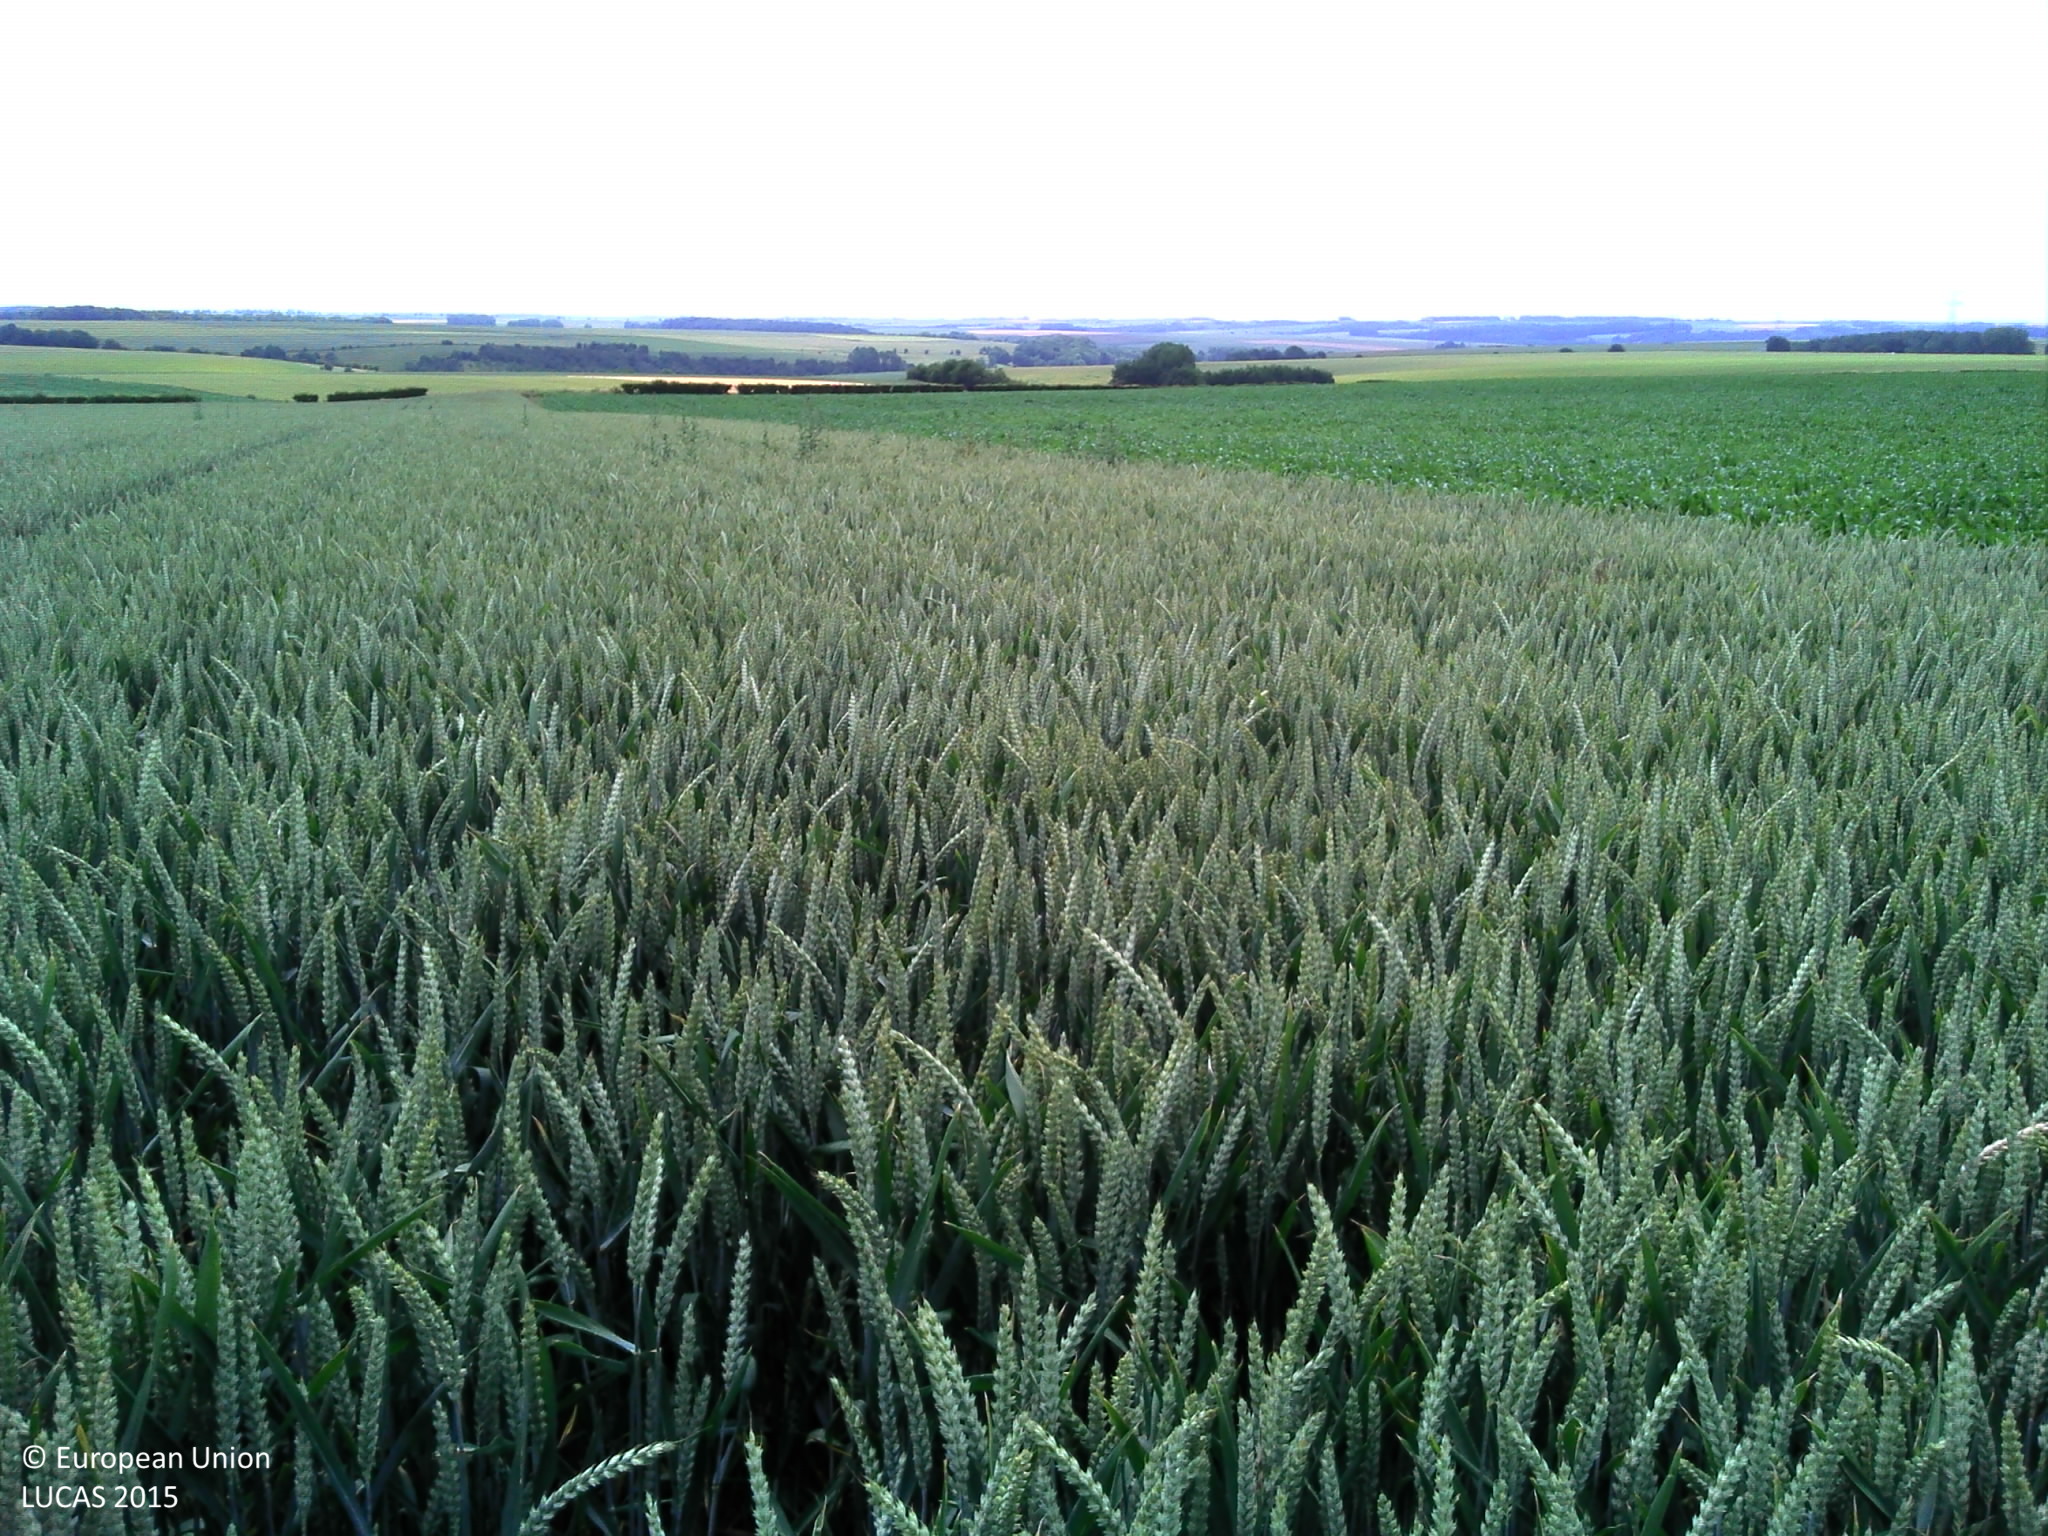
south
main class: Cropland
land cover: Common wheat
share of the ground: > 75 %
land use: Agriculture (excluding fallow land and kitchen gardens)
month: July
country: FR
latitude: 50.3832
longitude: 2.1519
